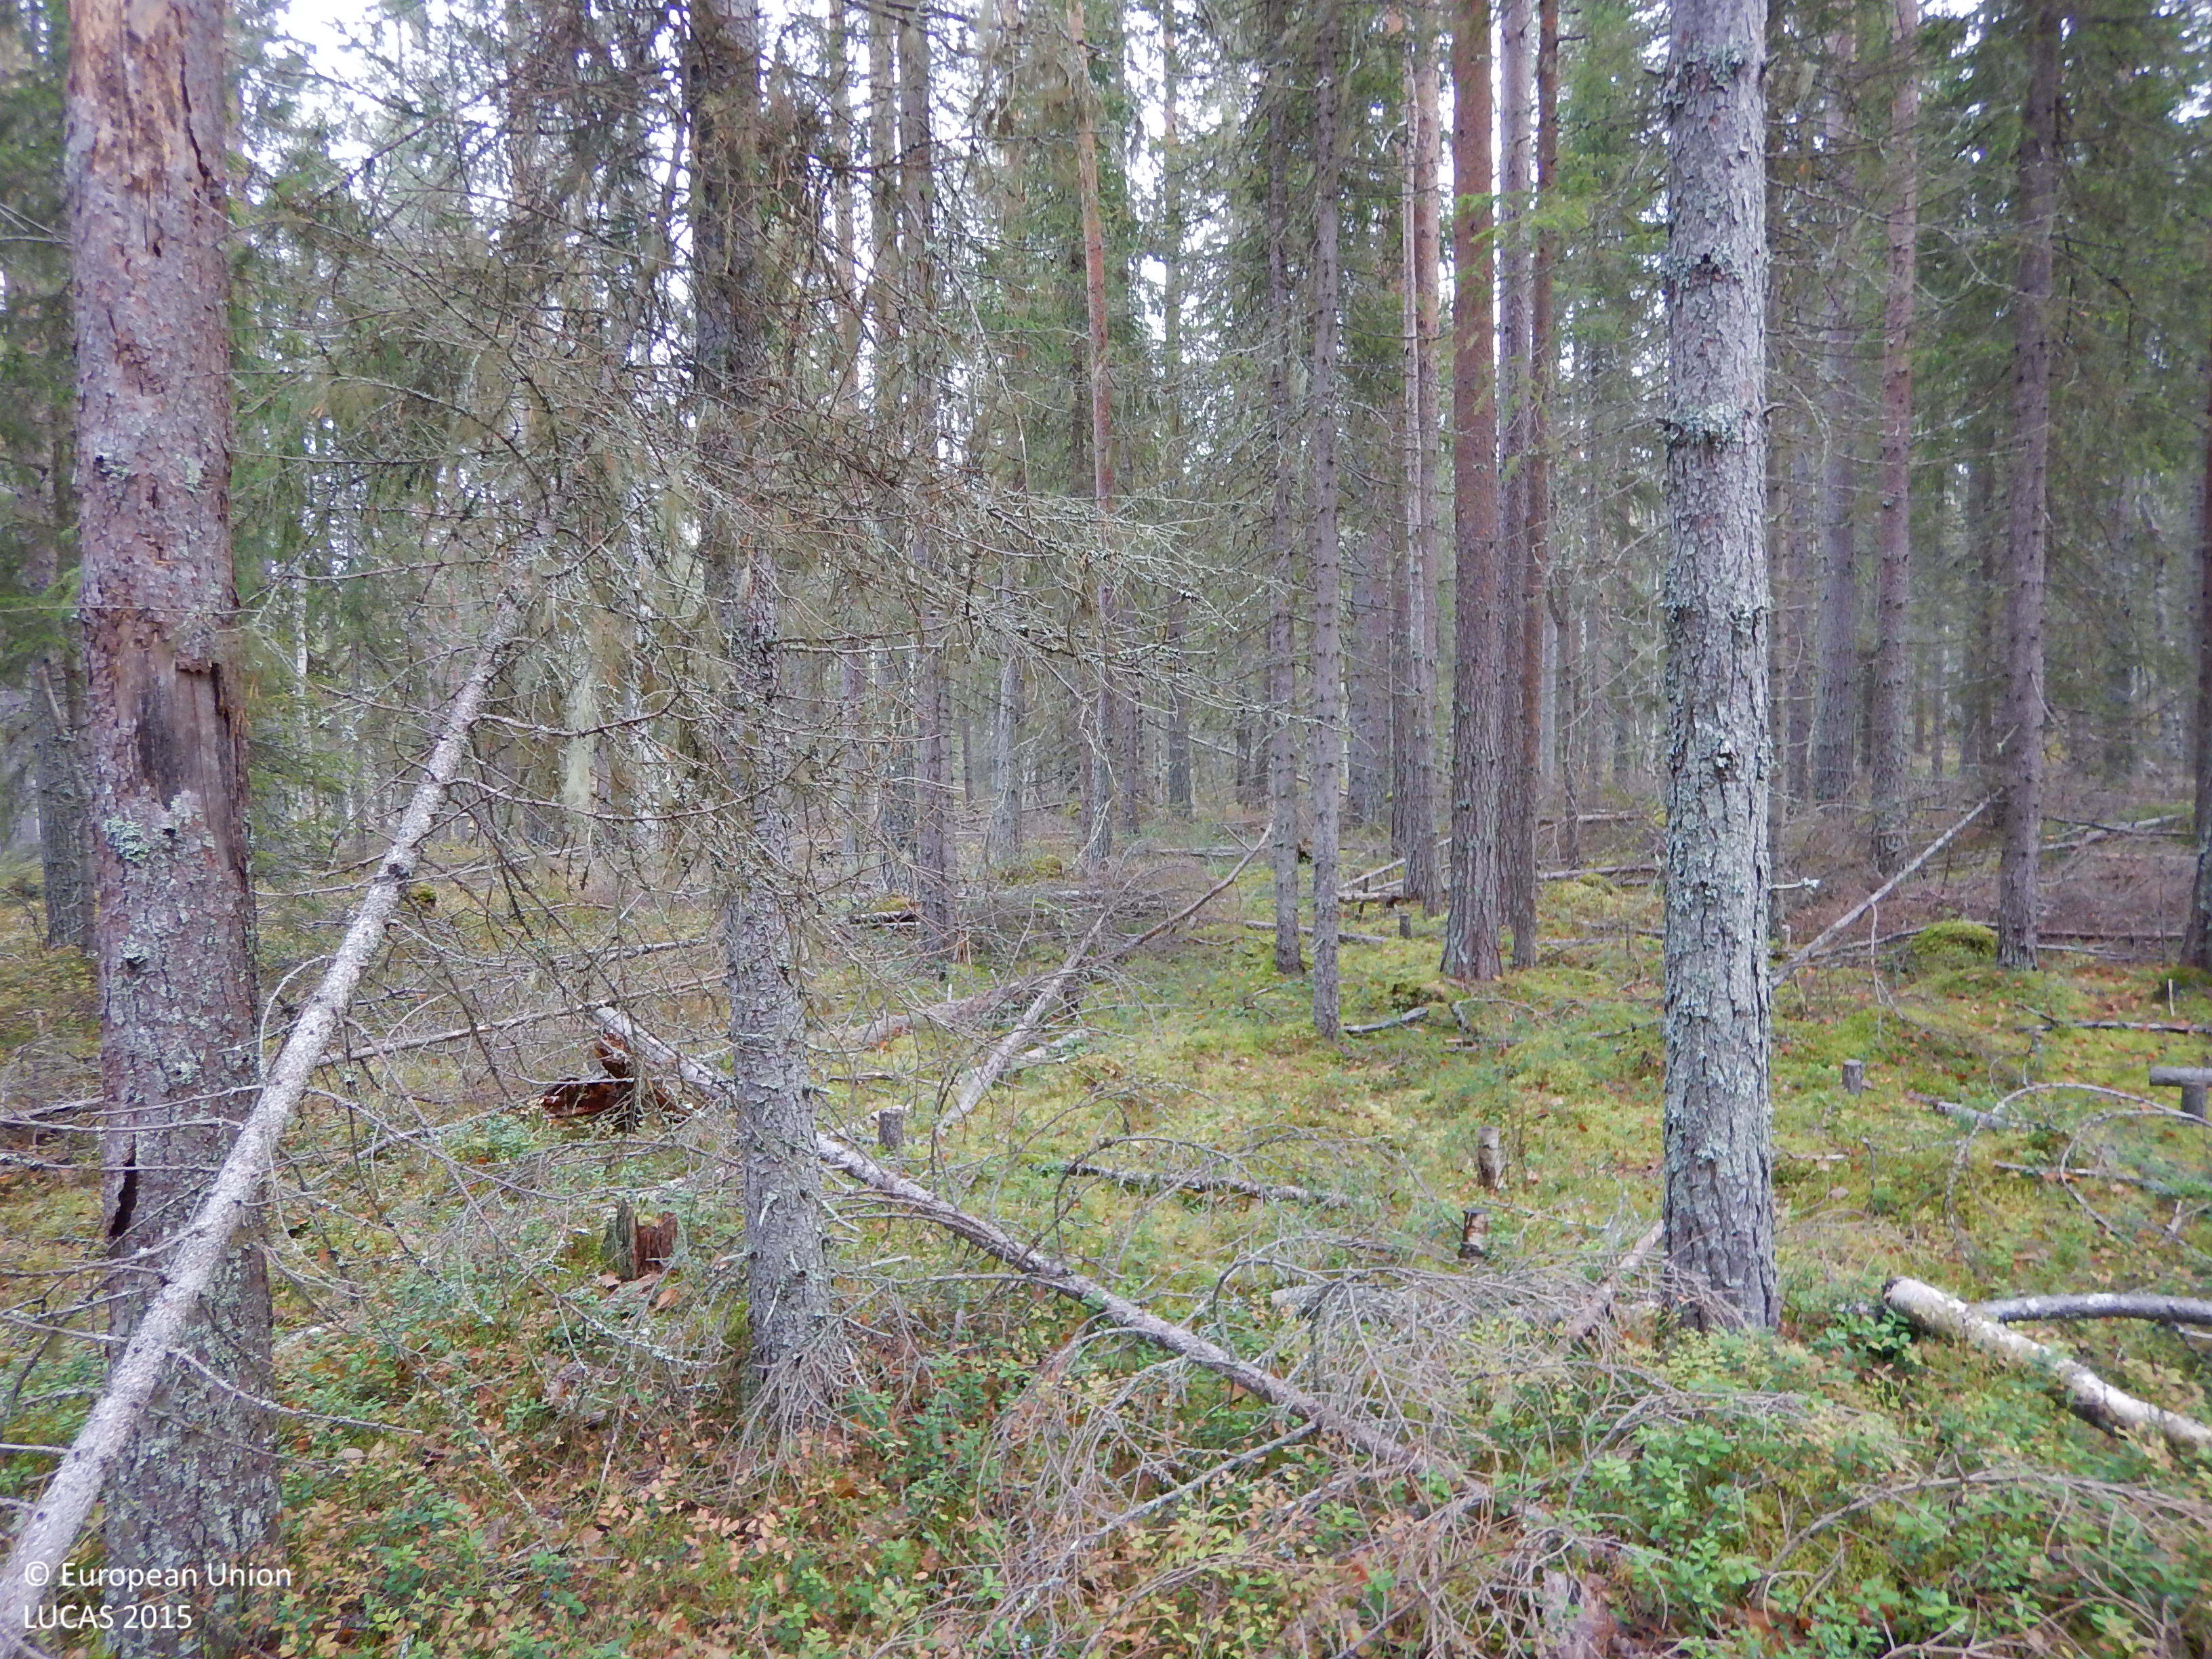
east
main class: Woodland
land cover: Other coniferous woodland
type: boreal forest
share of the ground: 50 - 75 %
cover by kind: coniferous forest trees 60 %, shrubs 15 %, lichens and mosses 15 %, broadleaved forest trees 5 %, herbaceous plants 5 %
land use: Forestry
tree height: > 5 m
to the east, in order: Other coniferous woodland; Rivers and streams; Spruce dominated mixed woodland; Pine dominated mixed woodland; Rivers and streams; Pine dominated mixed woodland; Pine dominated coniferous woodland; Ditches and canals; Pine dominated mixed woodland
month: October
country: SE
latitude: 65.1696
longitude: 20.1057
